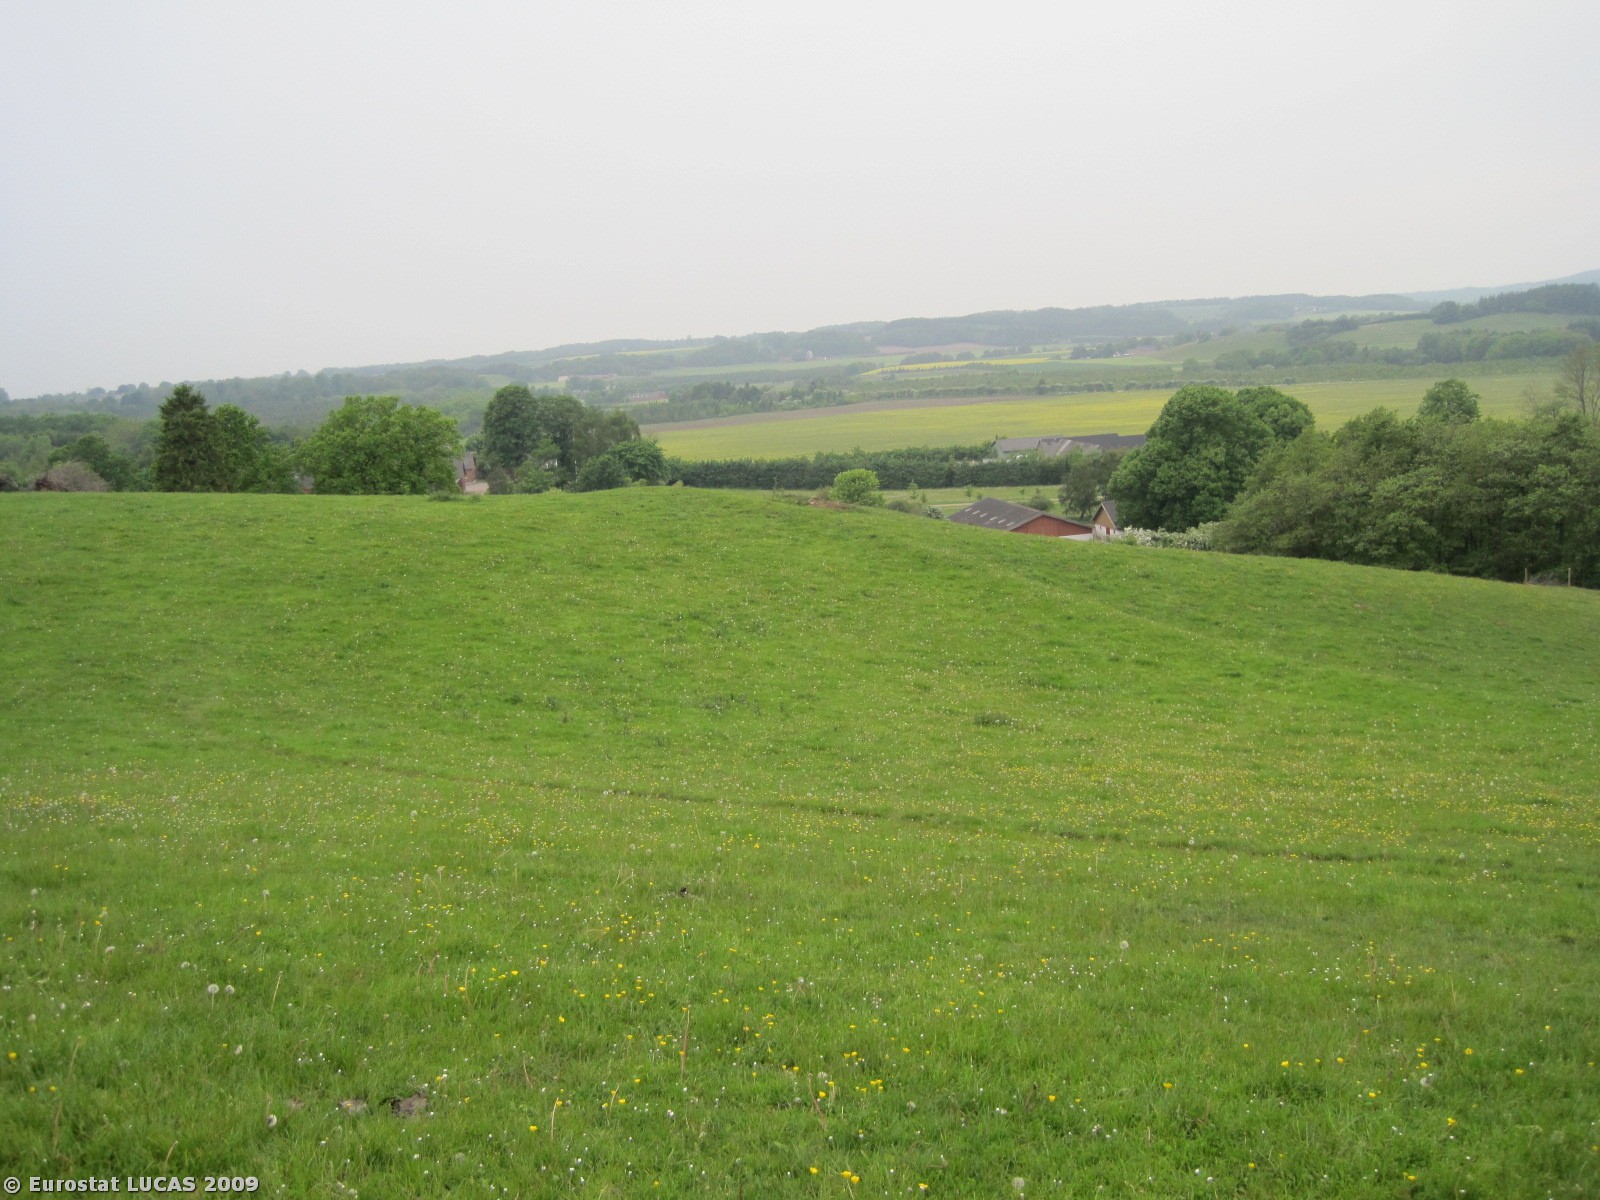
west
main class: Grassland
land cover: Grassland without tree/shrub cover
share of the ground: > 75 %
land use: Agriculture (excluding fallow land and kitchen gardens)
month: May
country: DK
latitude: 56.3136
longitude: 10.0161
